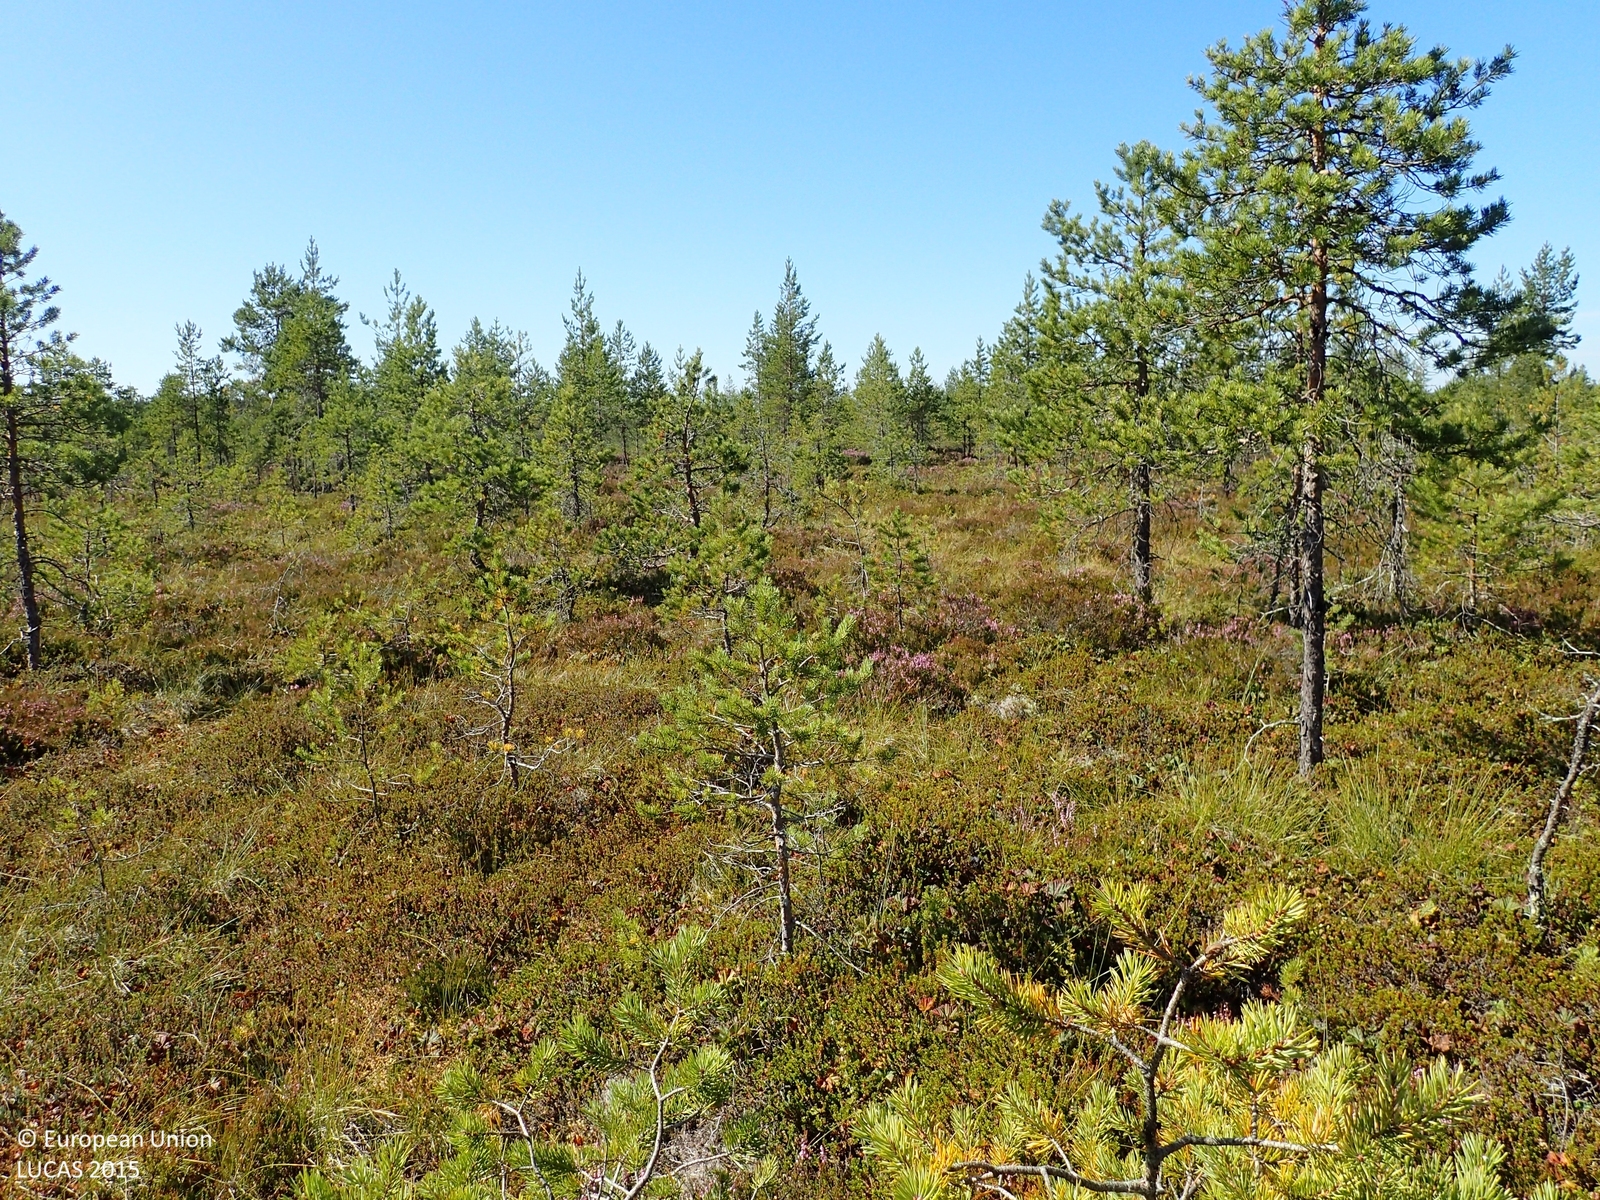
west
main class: Woodland
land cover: Pine dominated coniferous woodland
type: mire and swamp forests
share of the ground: 25 - 50 %
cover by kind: shrubs 50 %, coniferous forest trees 25 %, herbaceous plants 20 %, lichens and mosses 5 %
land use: Amenities, museums, leisure
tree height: < 5 m
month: August
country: FI
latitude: 62.5065
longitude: 22.5412
